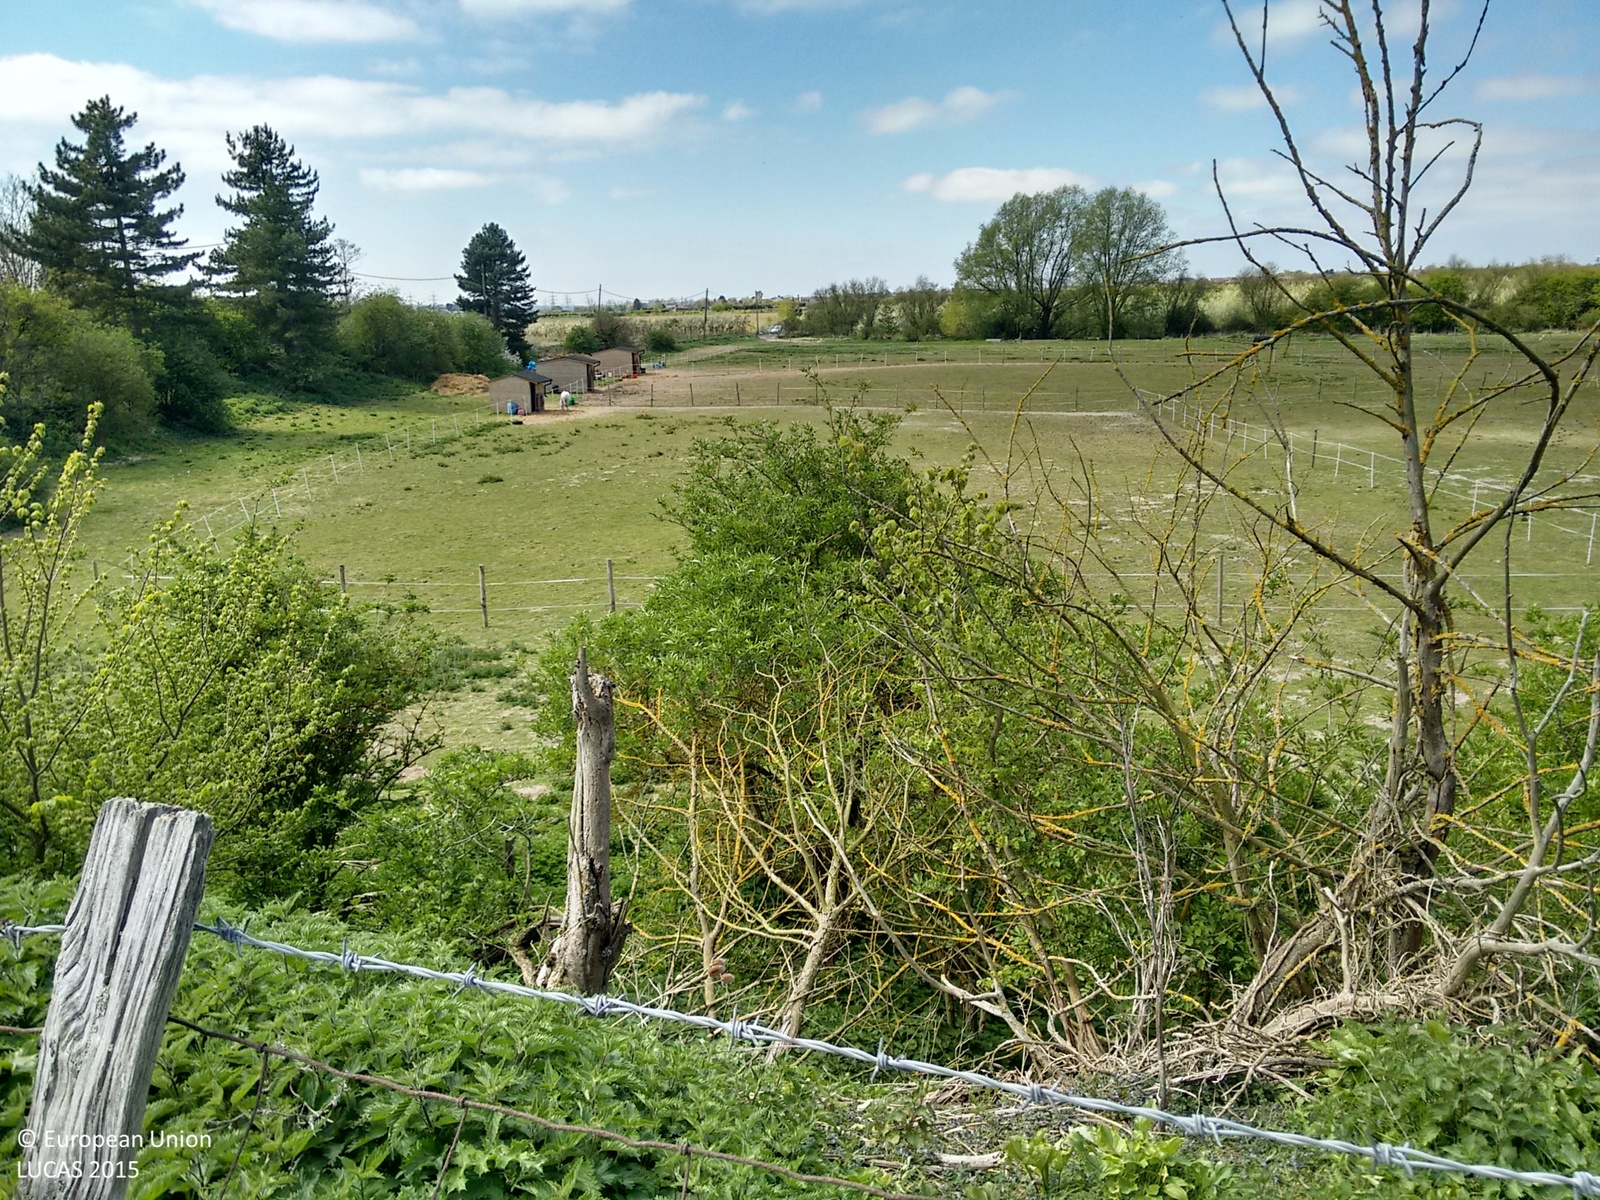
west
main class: Grassland
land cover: Grassland without tree/shrub cover
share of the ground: > 75 %
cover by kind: herbaceous plants 80 %, unconsolidated bare surface 20 %
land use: Agriculture (excluding fallow land and kitchen gardens)
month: April
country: GB
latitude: 51.4540
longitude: 0.5174
